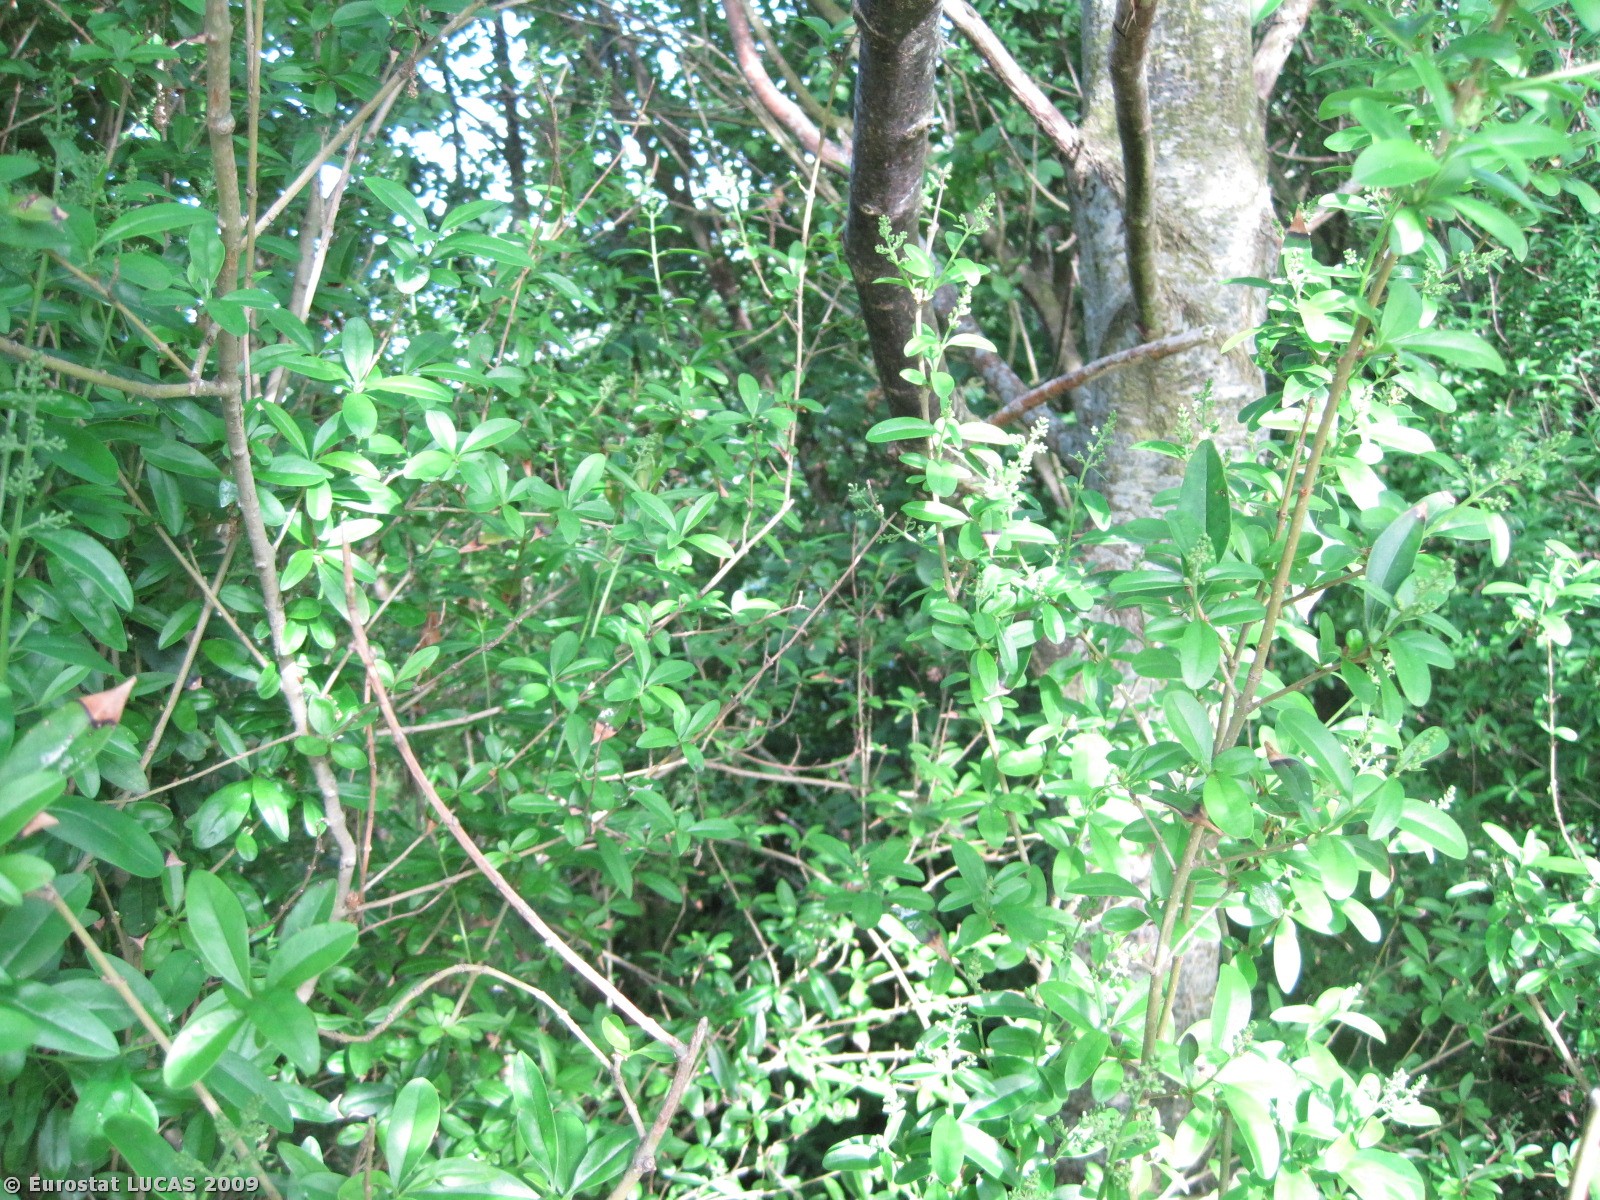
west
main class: Woodland
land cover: Broadleaved woodland
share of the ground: 50 - 75 %
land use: Amenities, museums, leisure
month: June
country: DK
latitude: 57.1046
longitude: 10.0824
